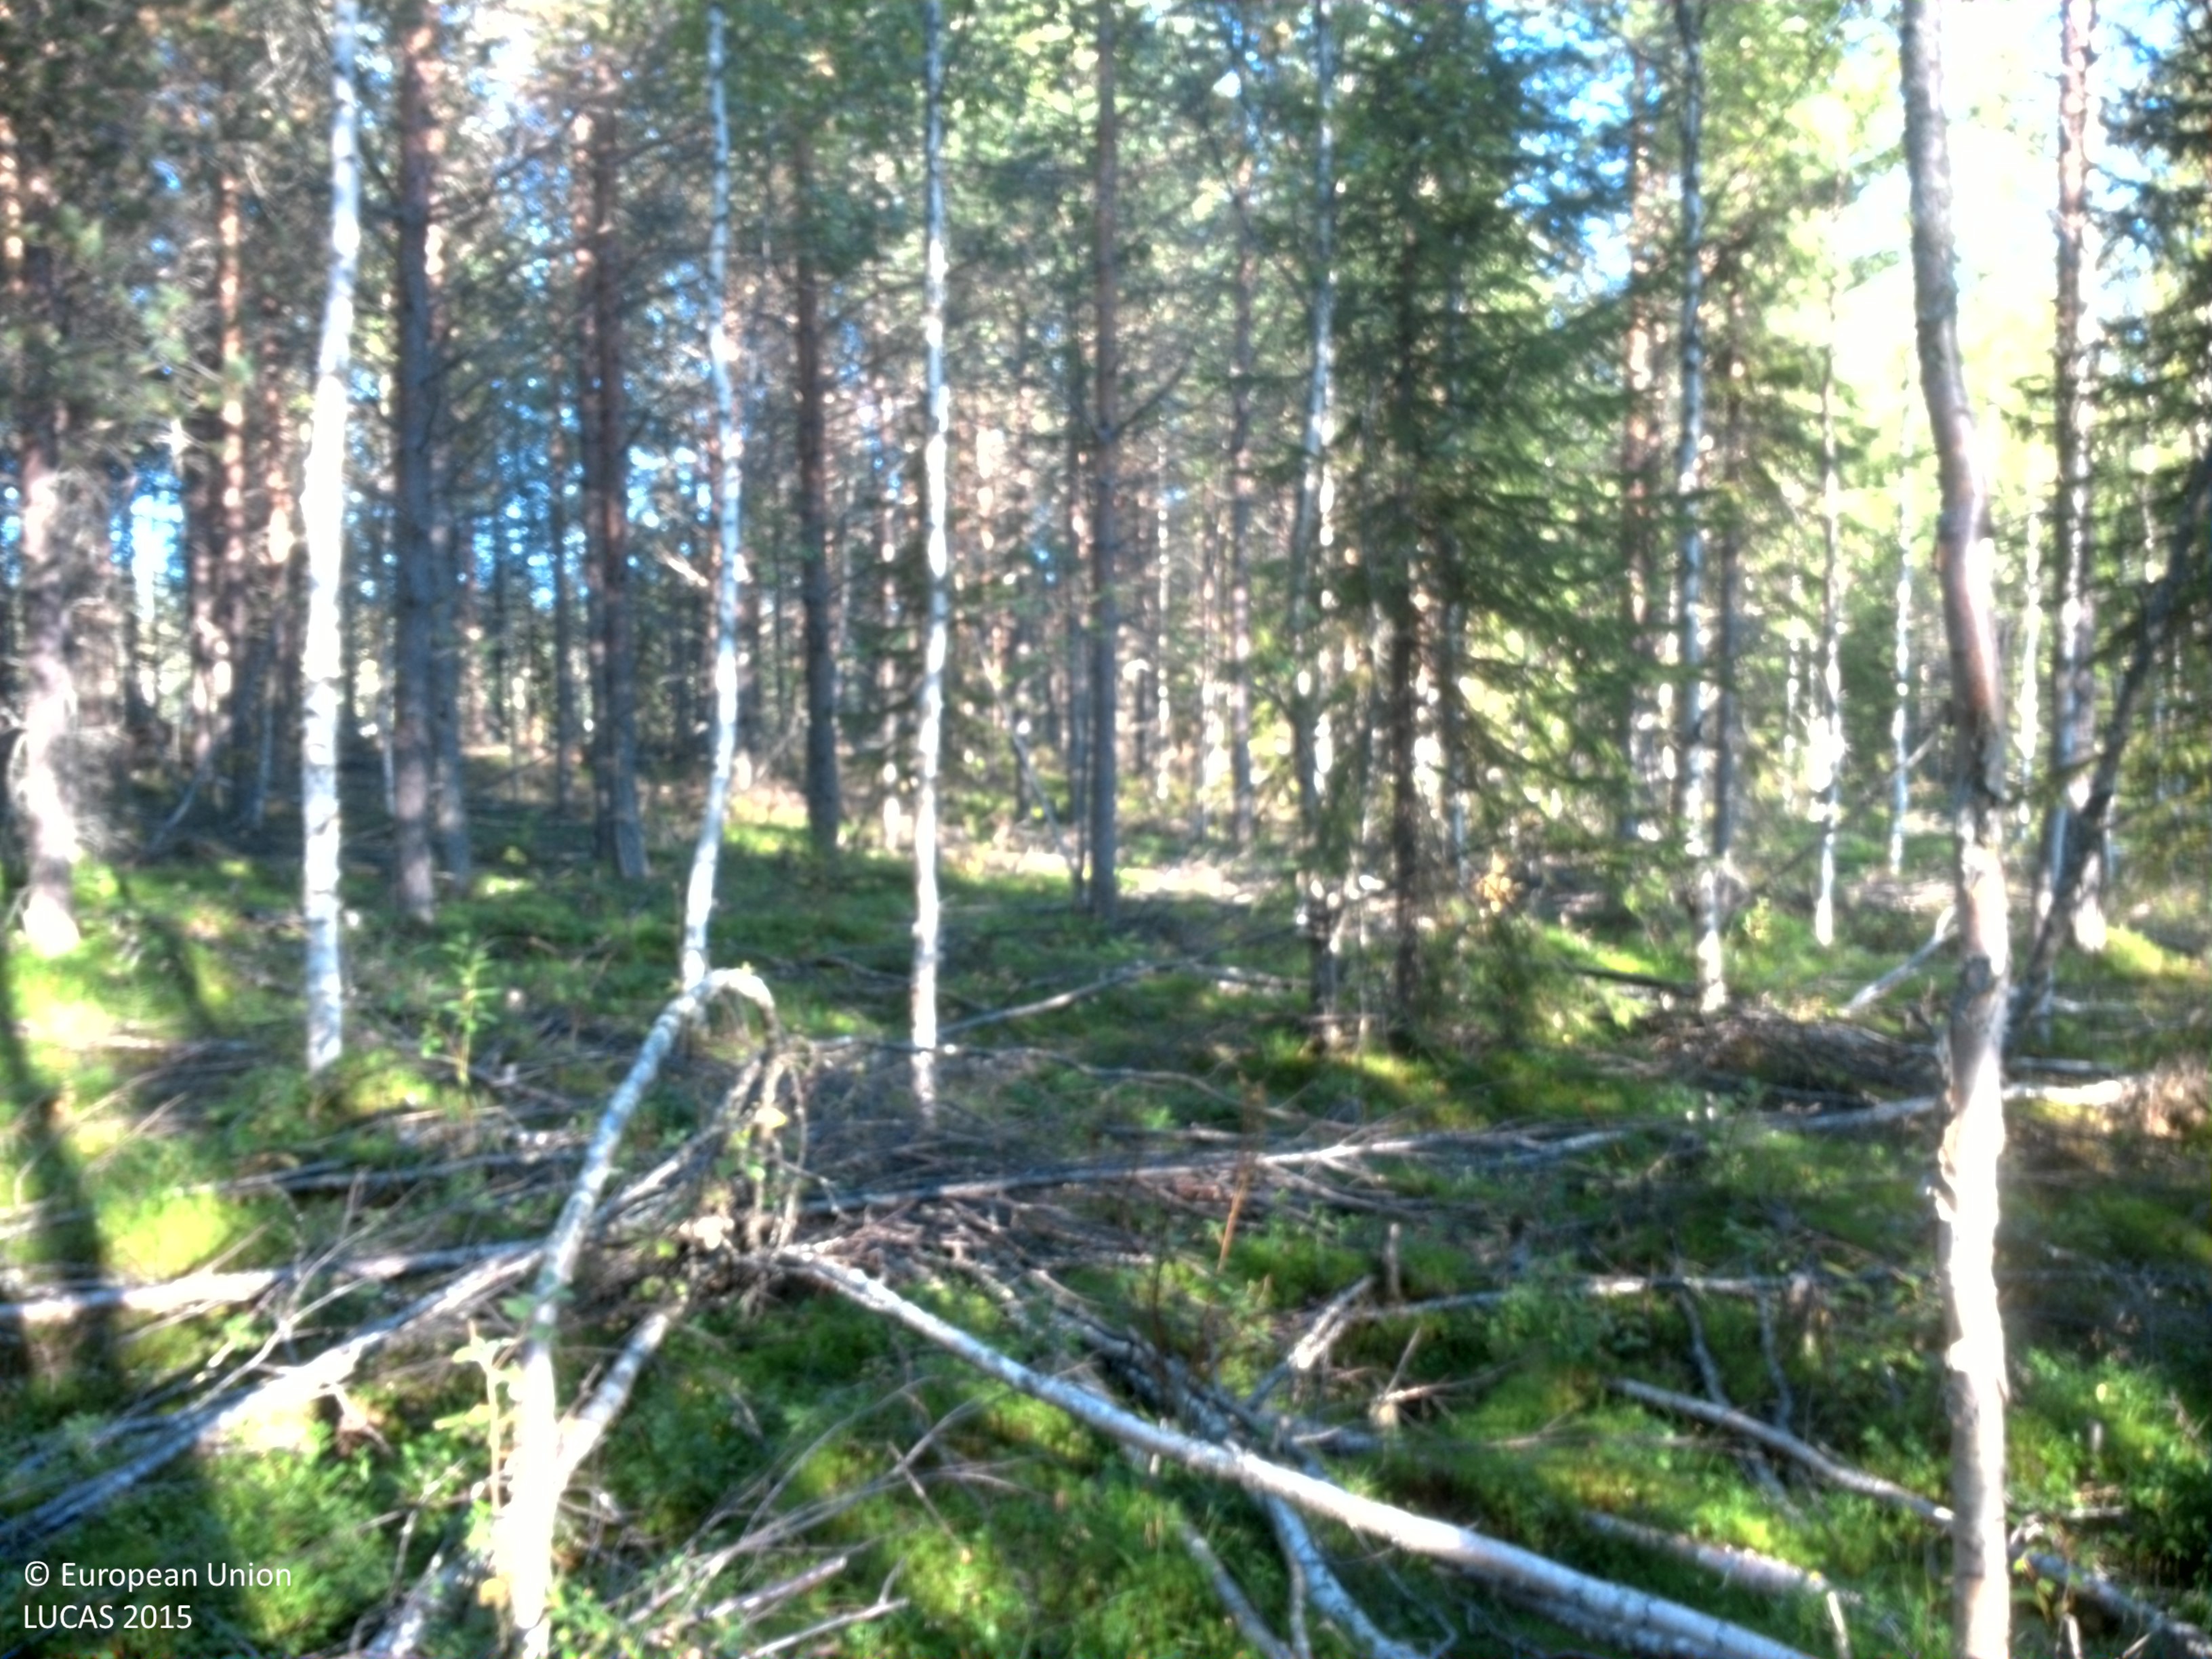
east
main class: Woodland
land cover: Other mixed woodland
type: boreal forest
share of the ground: 50 - 75 %
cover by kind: coniferous forest trees 40 %, broadleaved forest trees 30 %, shrubs 10 %, herbaceous plants 10 %, lichens and mosses 10 %
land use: Forestry
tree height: > 5 m
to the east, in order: Other mixed woodland; Pine dominated coniferous woodland; Pine dominated mixed woodland; Other mixed woodland; Other coniferous woodland
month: September
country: SE
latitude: 64.6727
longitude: 19.8816
